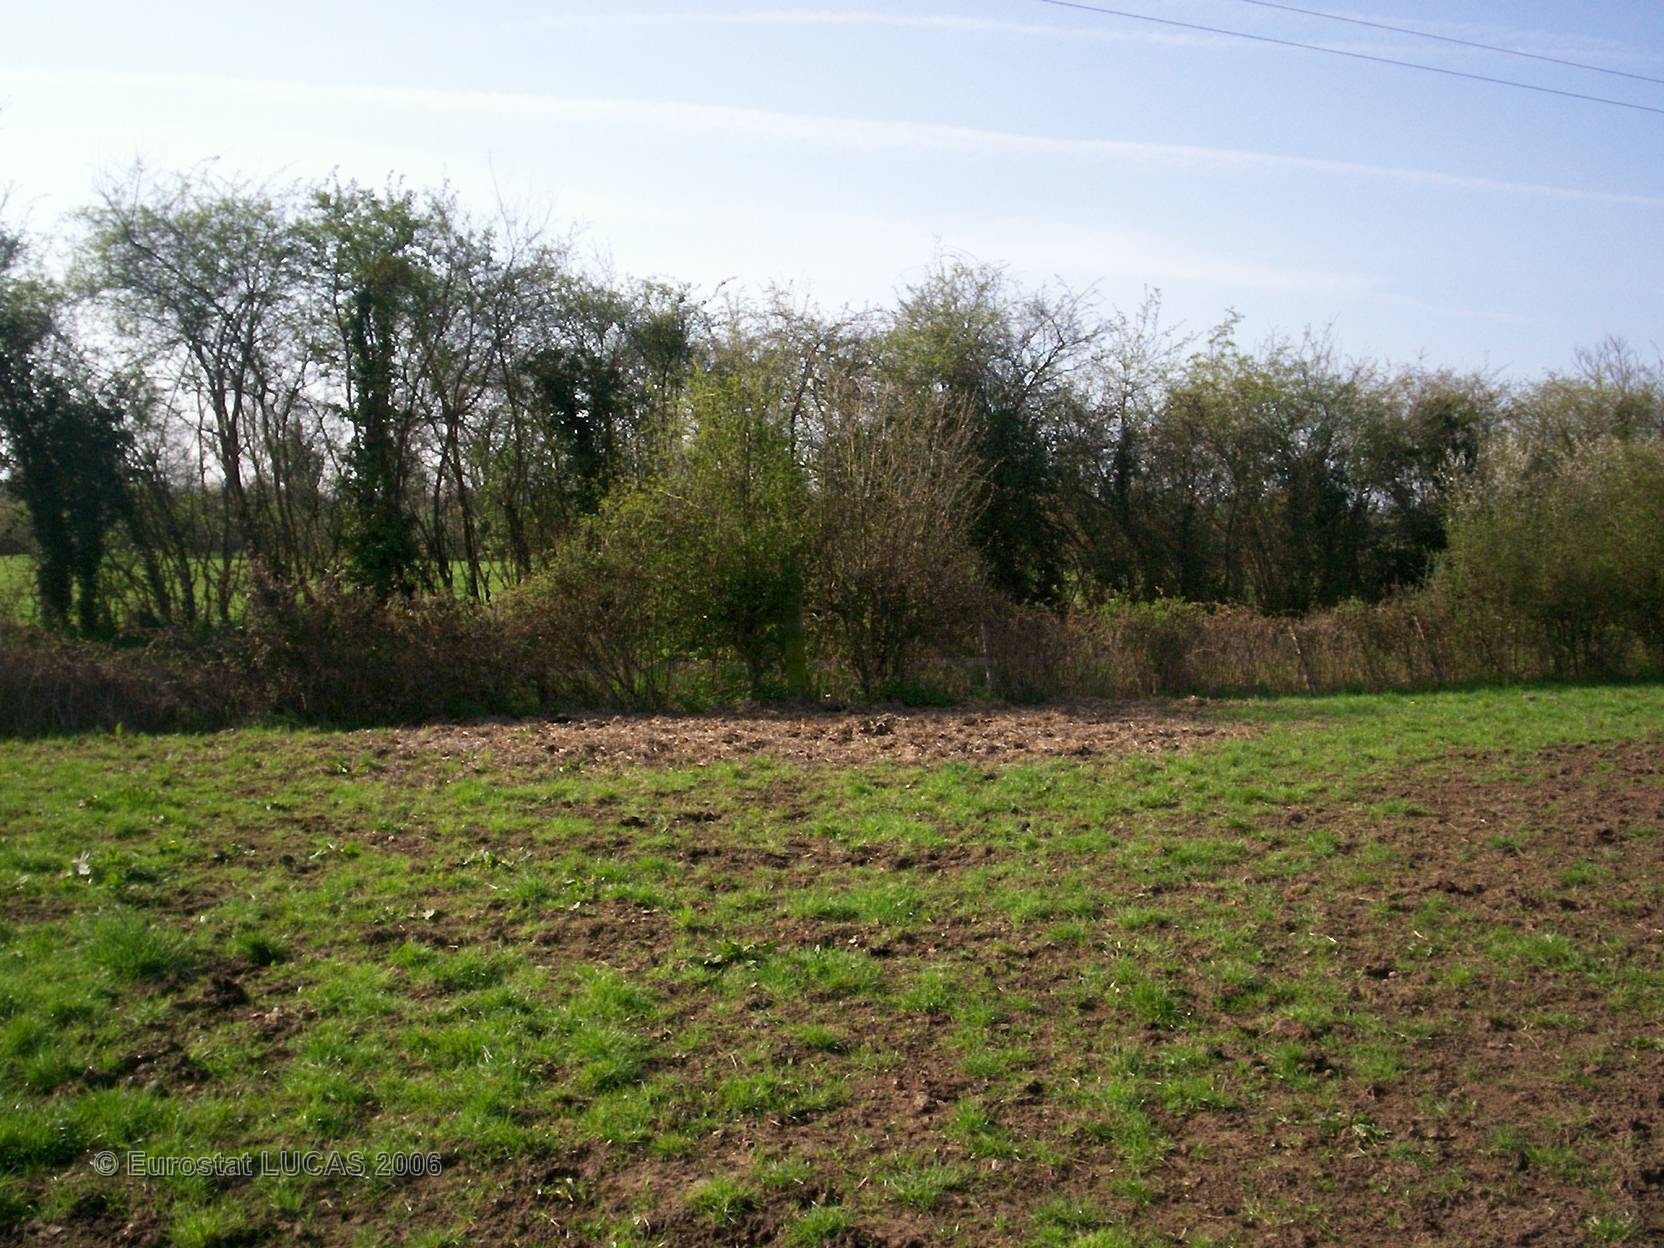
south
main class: Grassland
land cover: Grassland without tree/shrub cover
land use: Agriculture (excluding fallow land and kitchen gardens)
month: April
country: FR
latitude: 49.0898
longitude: -0.0136
